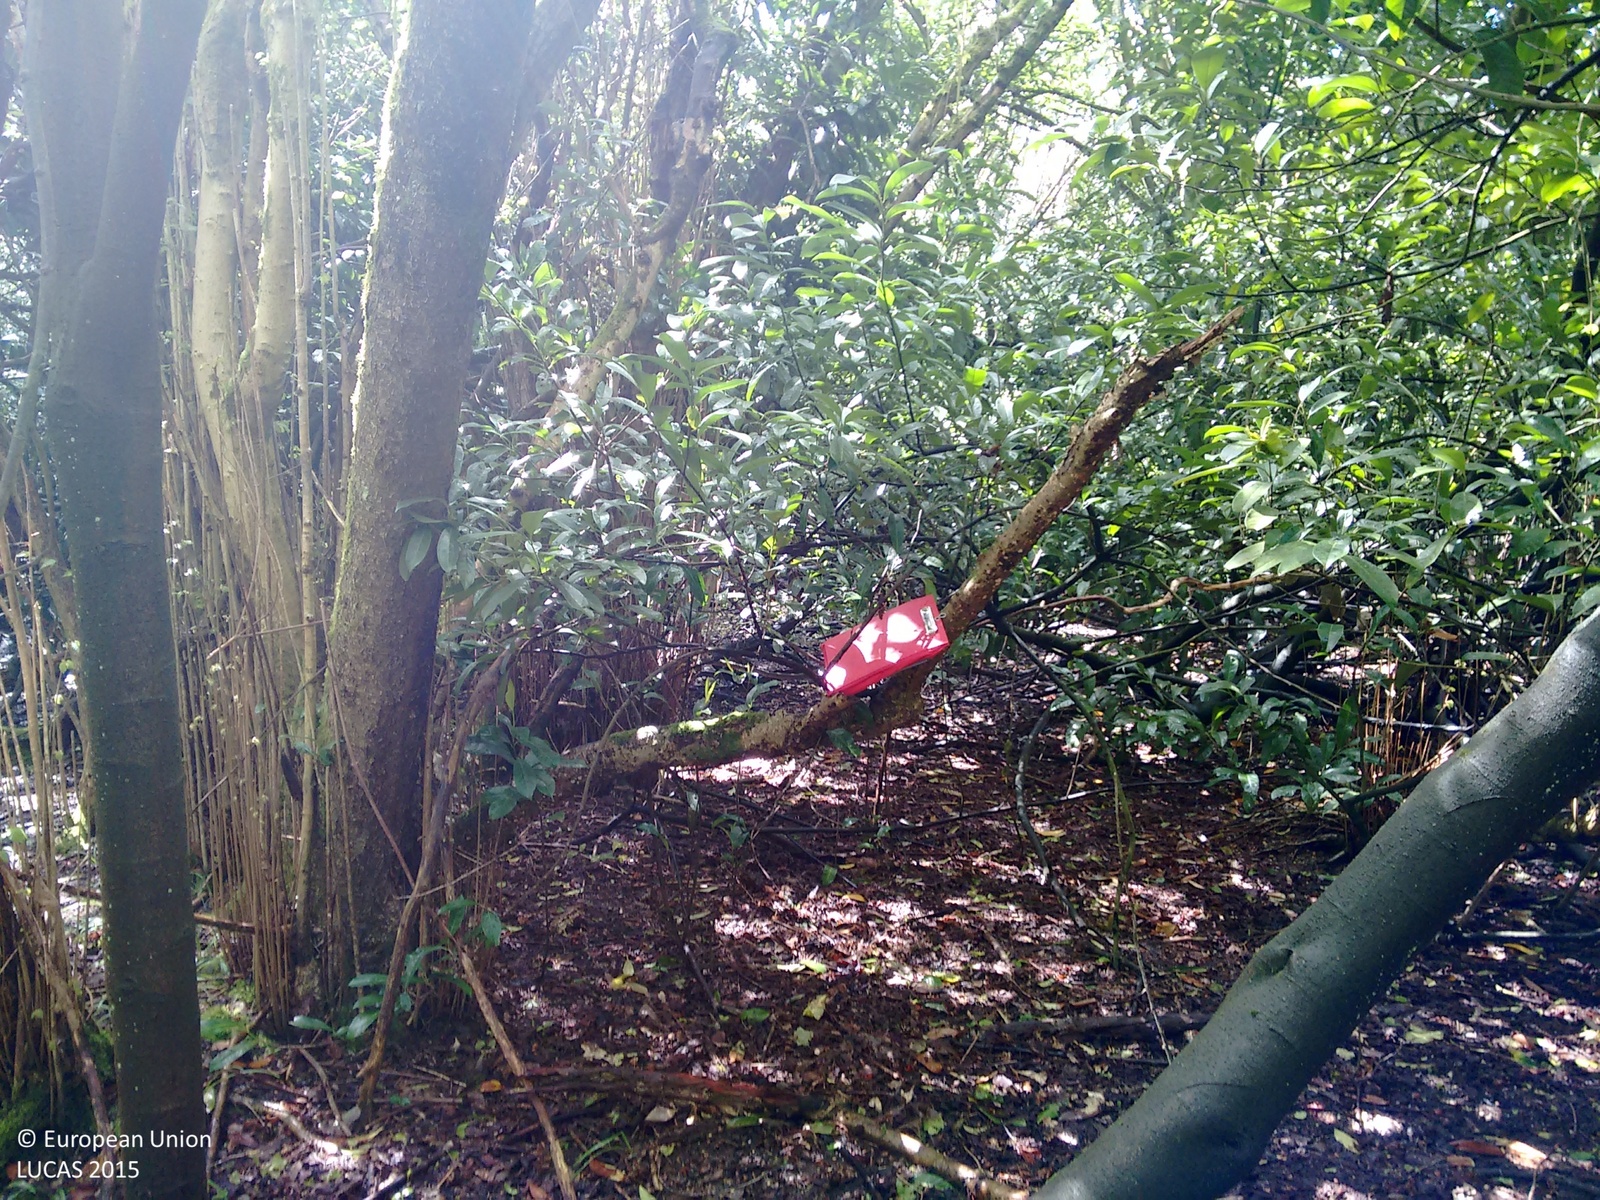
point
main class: Woodland
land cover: Broadleaved woodland
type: mesophytic deciduous forest
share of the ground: > 75 %
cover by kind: broadleaved forest trees 100 %
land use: Forestry
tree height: > 5 m
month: May
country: GB
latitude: 51.3115
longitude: 0.1124
